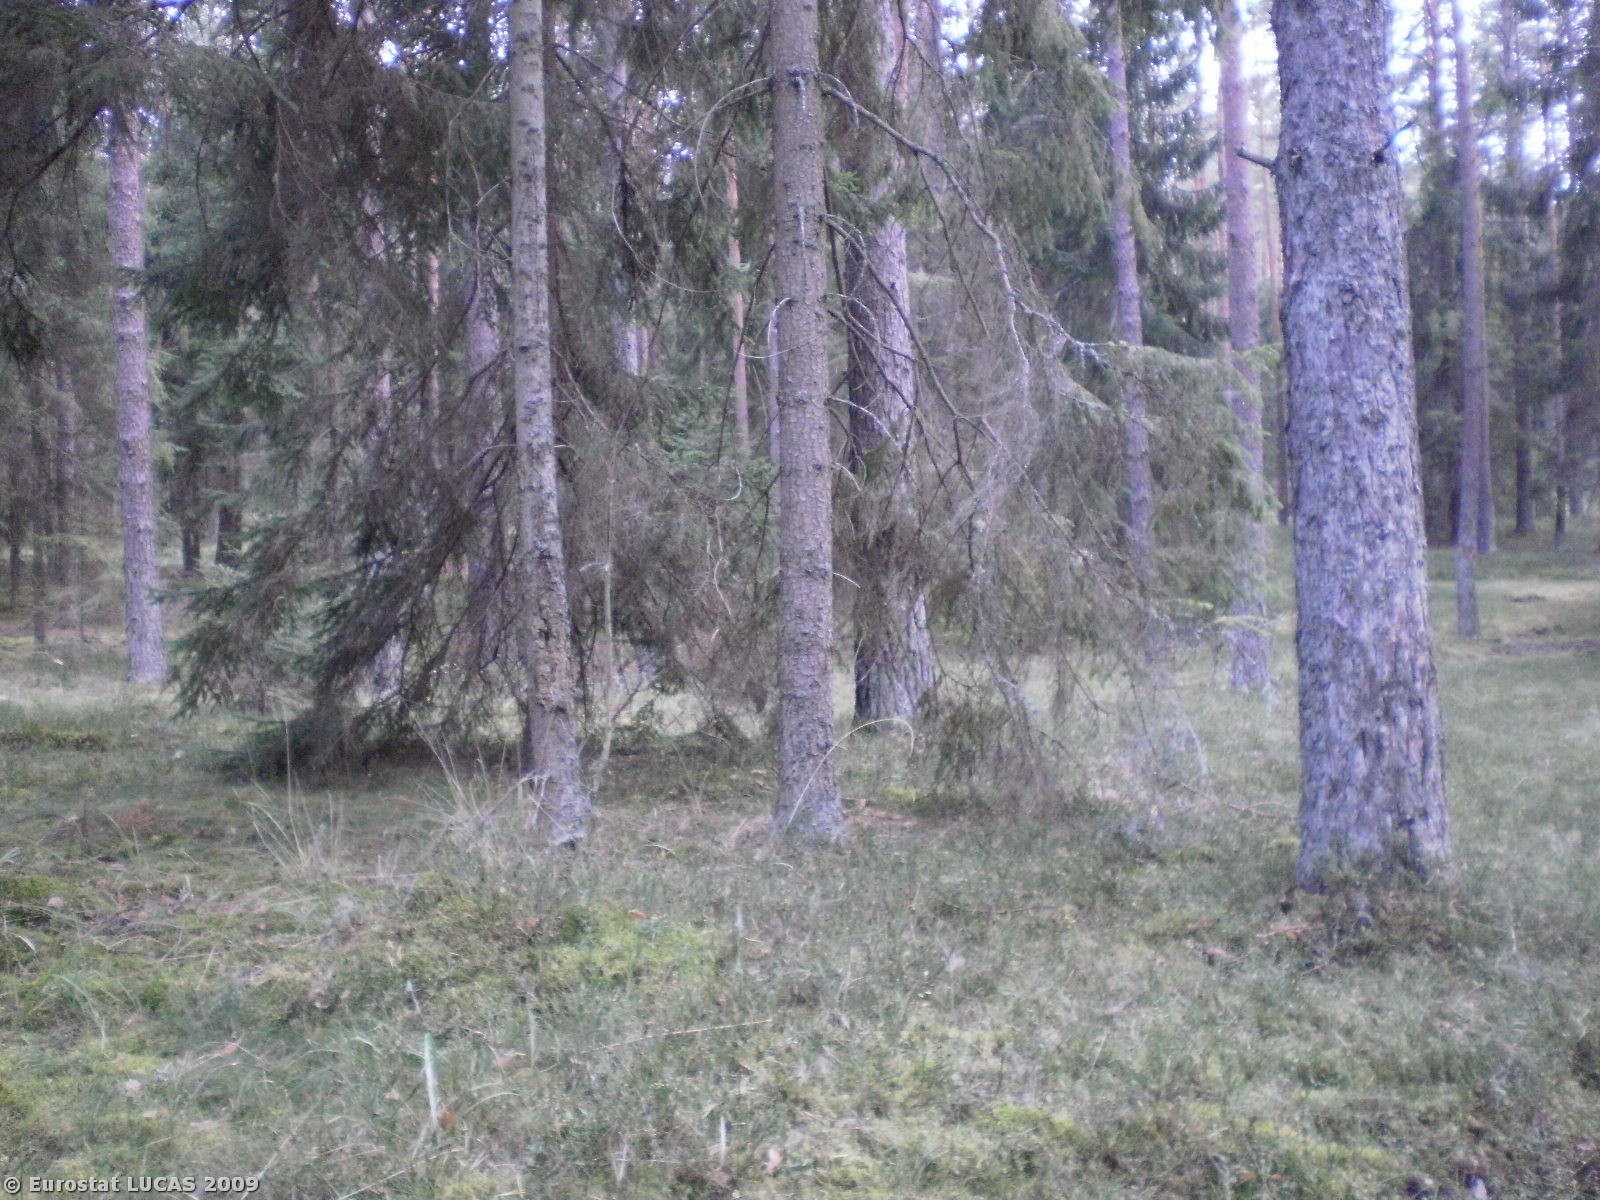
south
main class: Woodland
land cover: Coniferous woodland
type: hemiboreal forest and nemoral coniferous forest and mixed broadleaved-coniferous forest
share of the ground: > 75 %
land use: Agriculture (excluding fallow land and kitchen gardens)
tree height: > 5 m
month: September
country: PL
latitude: 53.5837
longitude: 21.6377
